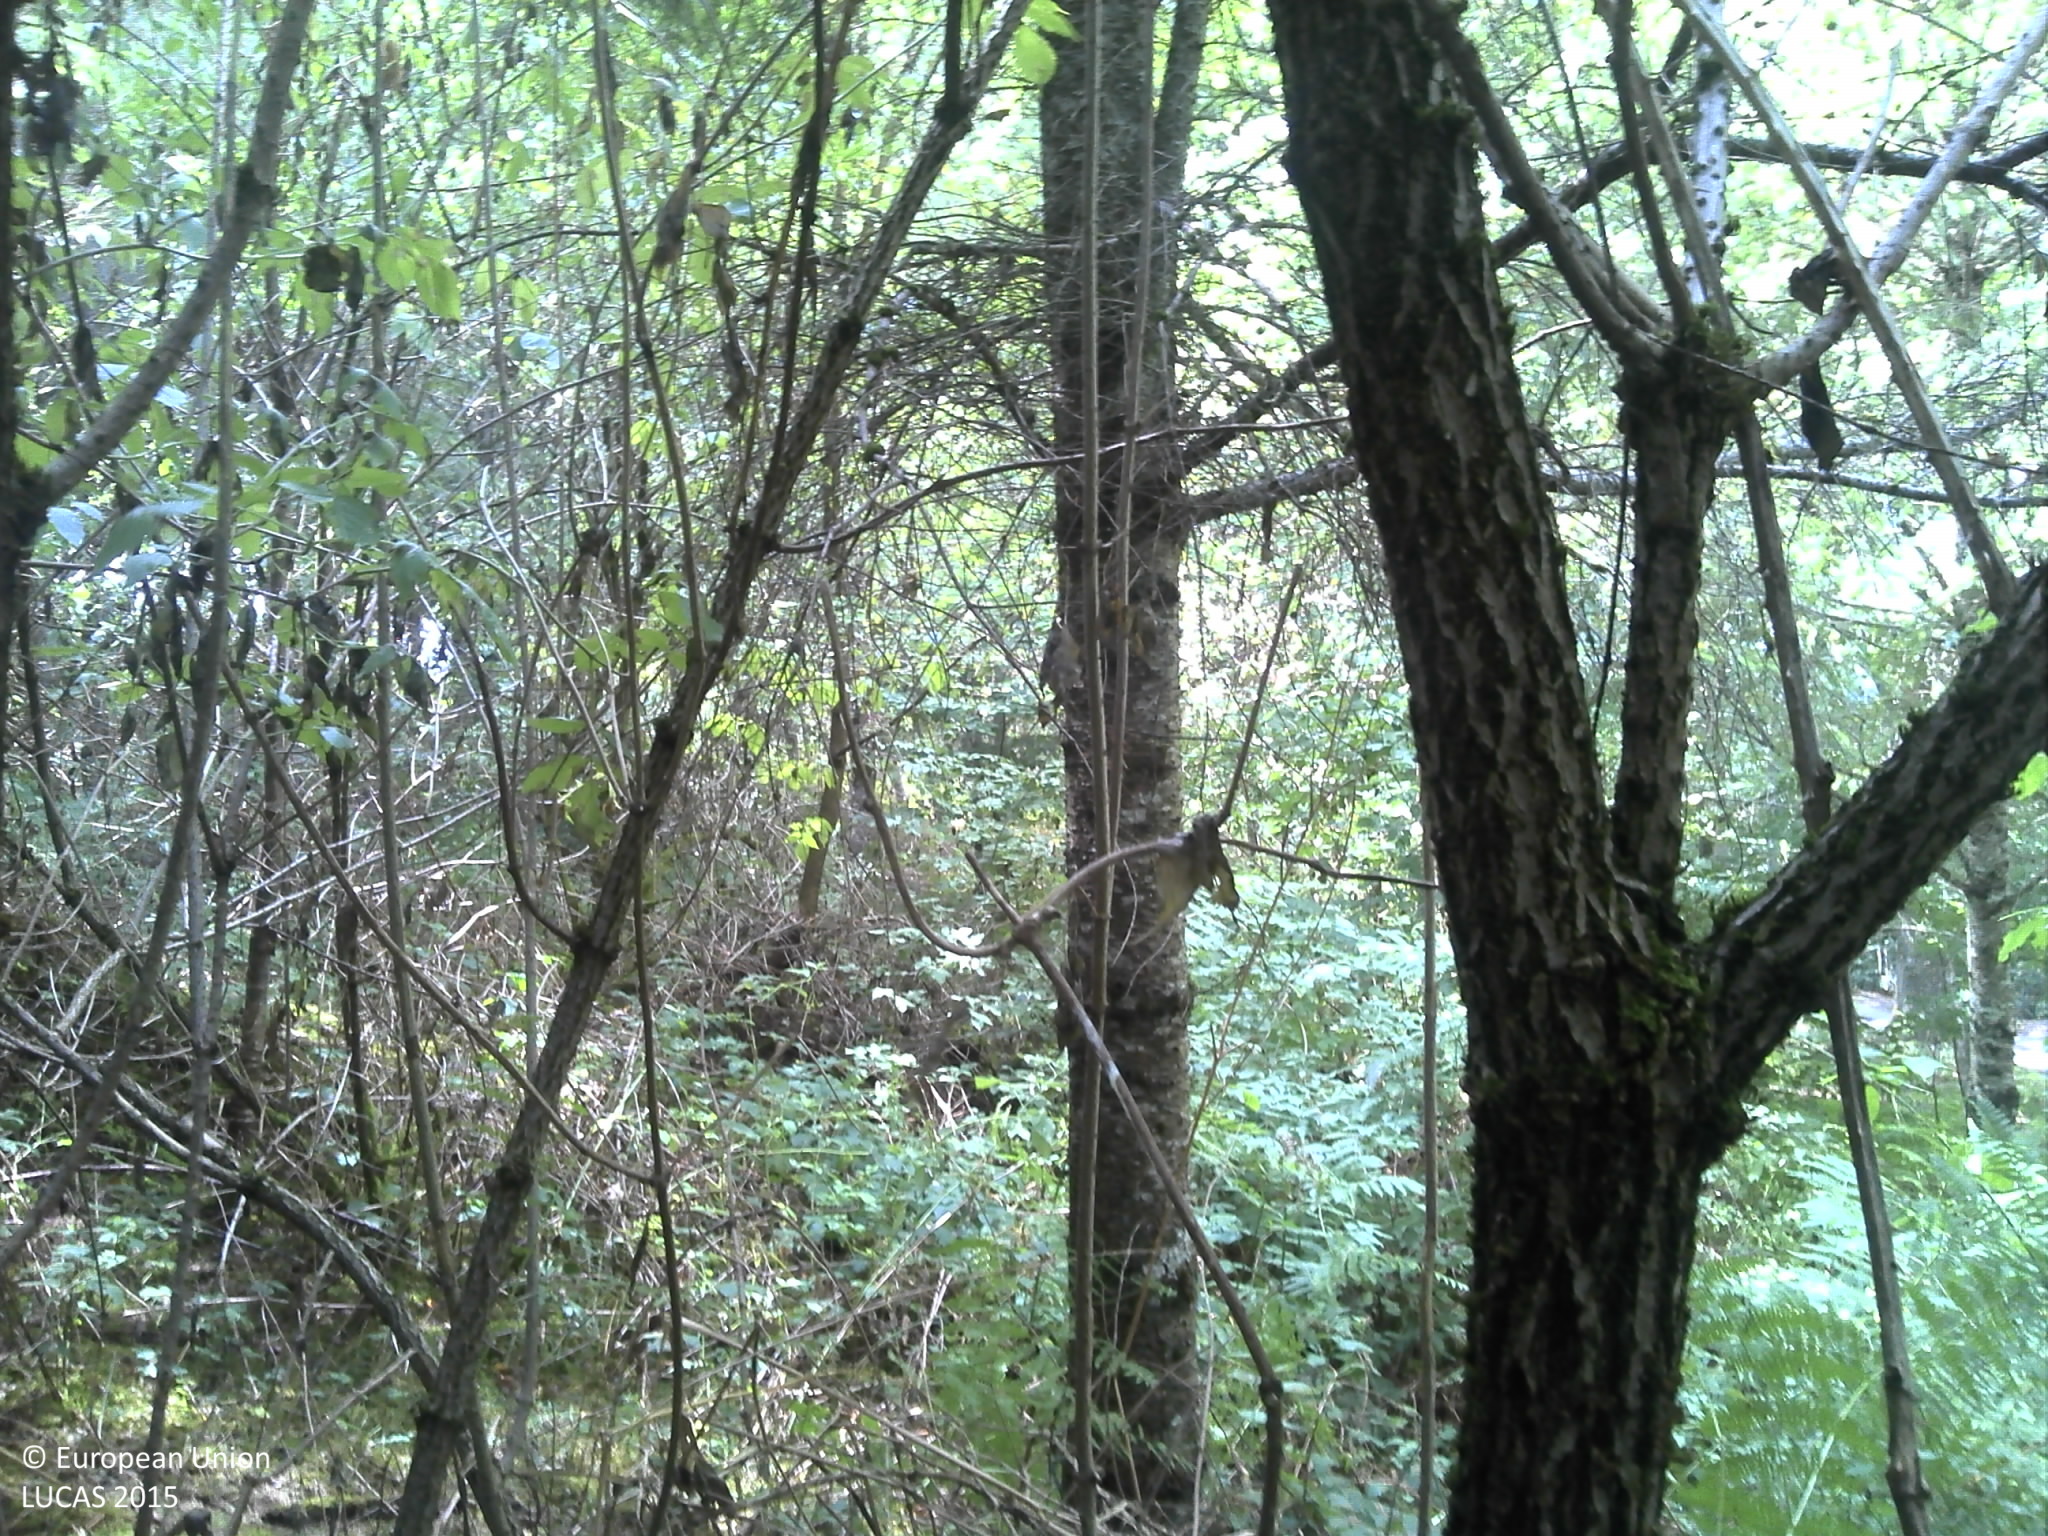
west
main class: Woodland
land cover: Other mixed woodland
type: mountainous beech forest
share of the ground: > 75 %
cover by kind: coniferous forest trees 40 %, broadleaved forest trees 20 %, herbaceous plants 20 %, lichens and mosses 20 %
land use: Forestry
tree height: > 5 m
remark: Nursery
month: August
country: FR
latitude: 45.5165
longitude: 2.3554
